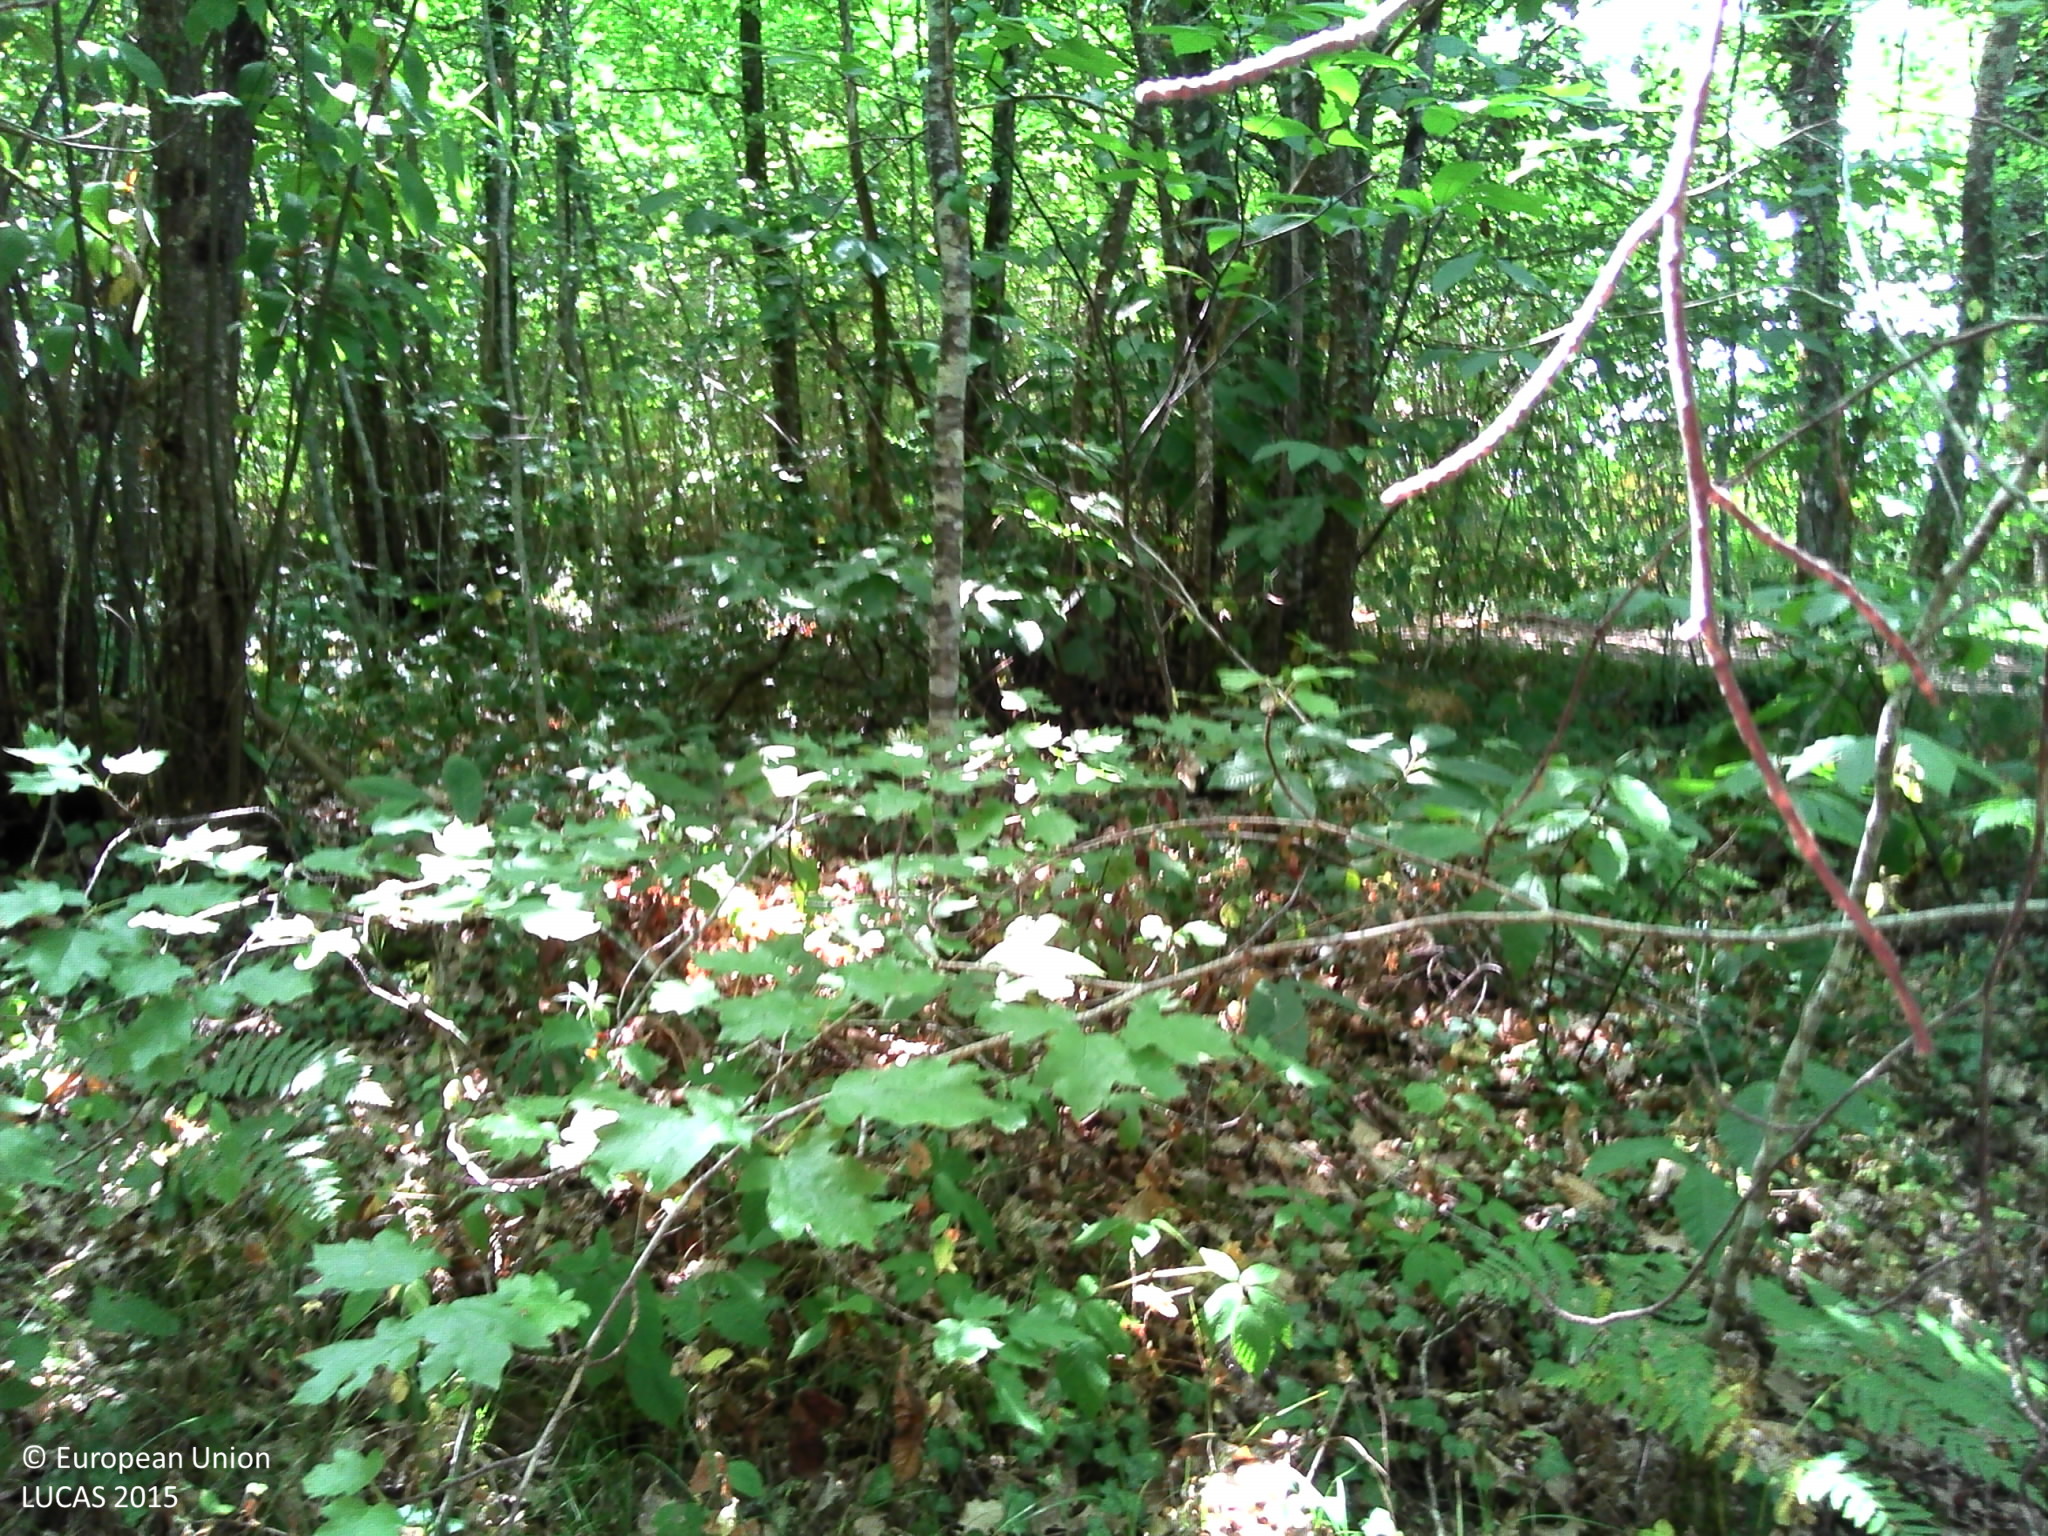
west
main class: Woodland
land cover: Broadleaved woodland
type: thermophilous deciduous forest
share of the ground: > 75 %
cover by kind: broadleaved forest trees 75 %, herbaceous plants 15 %, shrubs 10 %
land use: Forestry
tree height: > 5 m
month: July
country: FR
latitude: 45.1737
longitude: 0.7910
